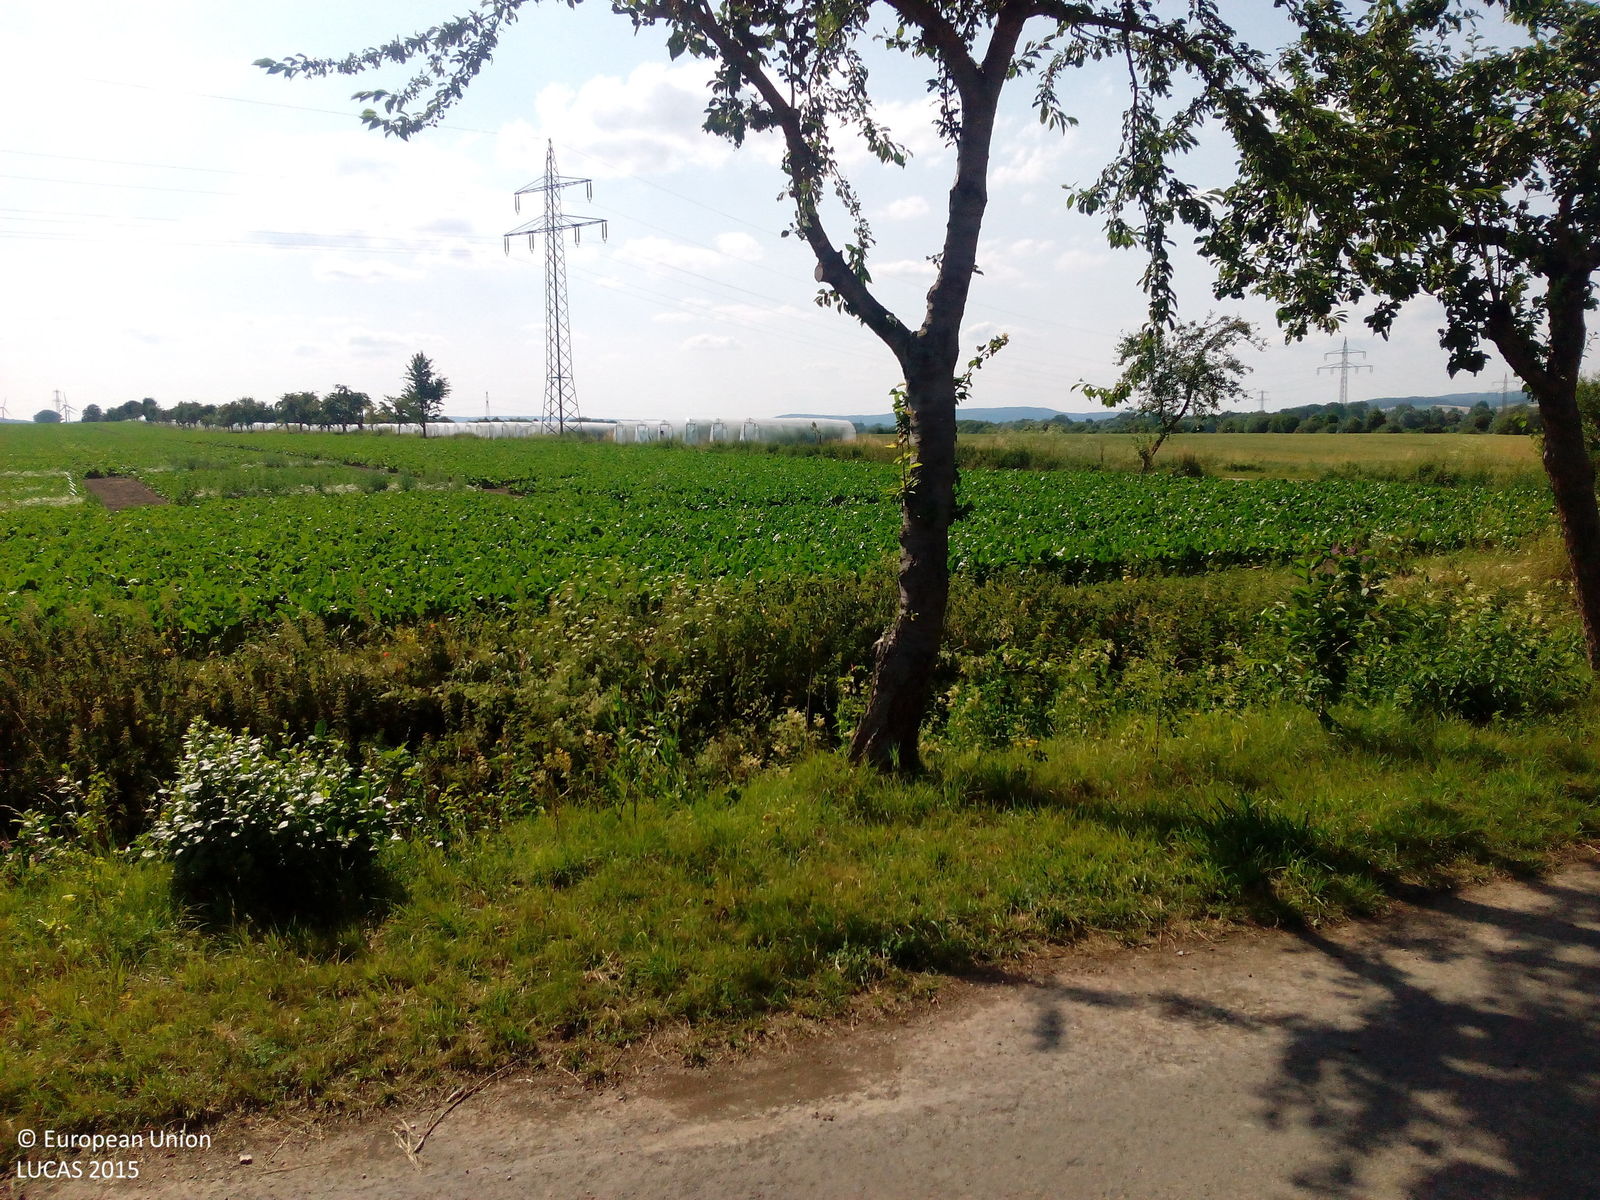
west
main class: Cropland
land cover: Common wheat
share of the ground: > 75 %
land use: Agriculture (excluding fallow land and kitchen gardens)
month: July
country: DE
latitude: 51.8022
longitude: 9.8695
